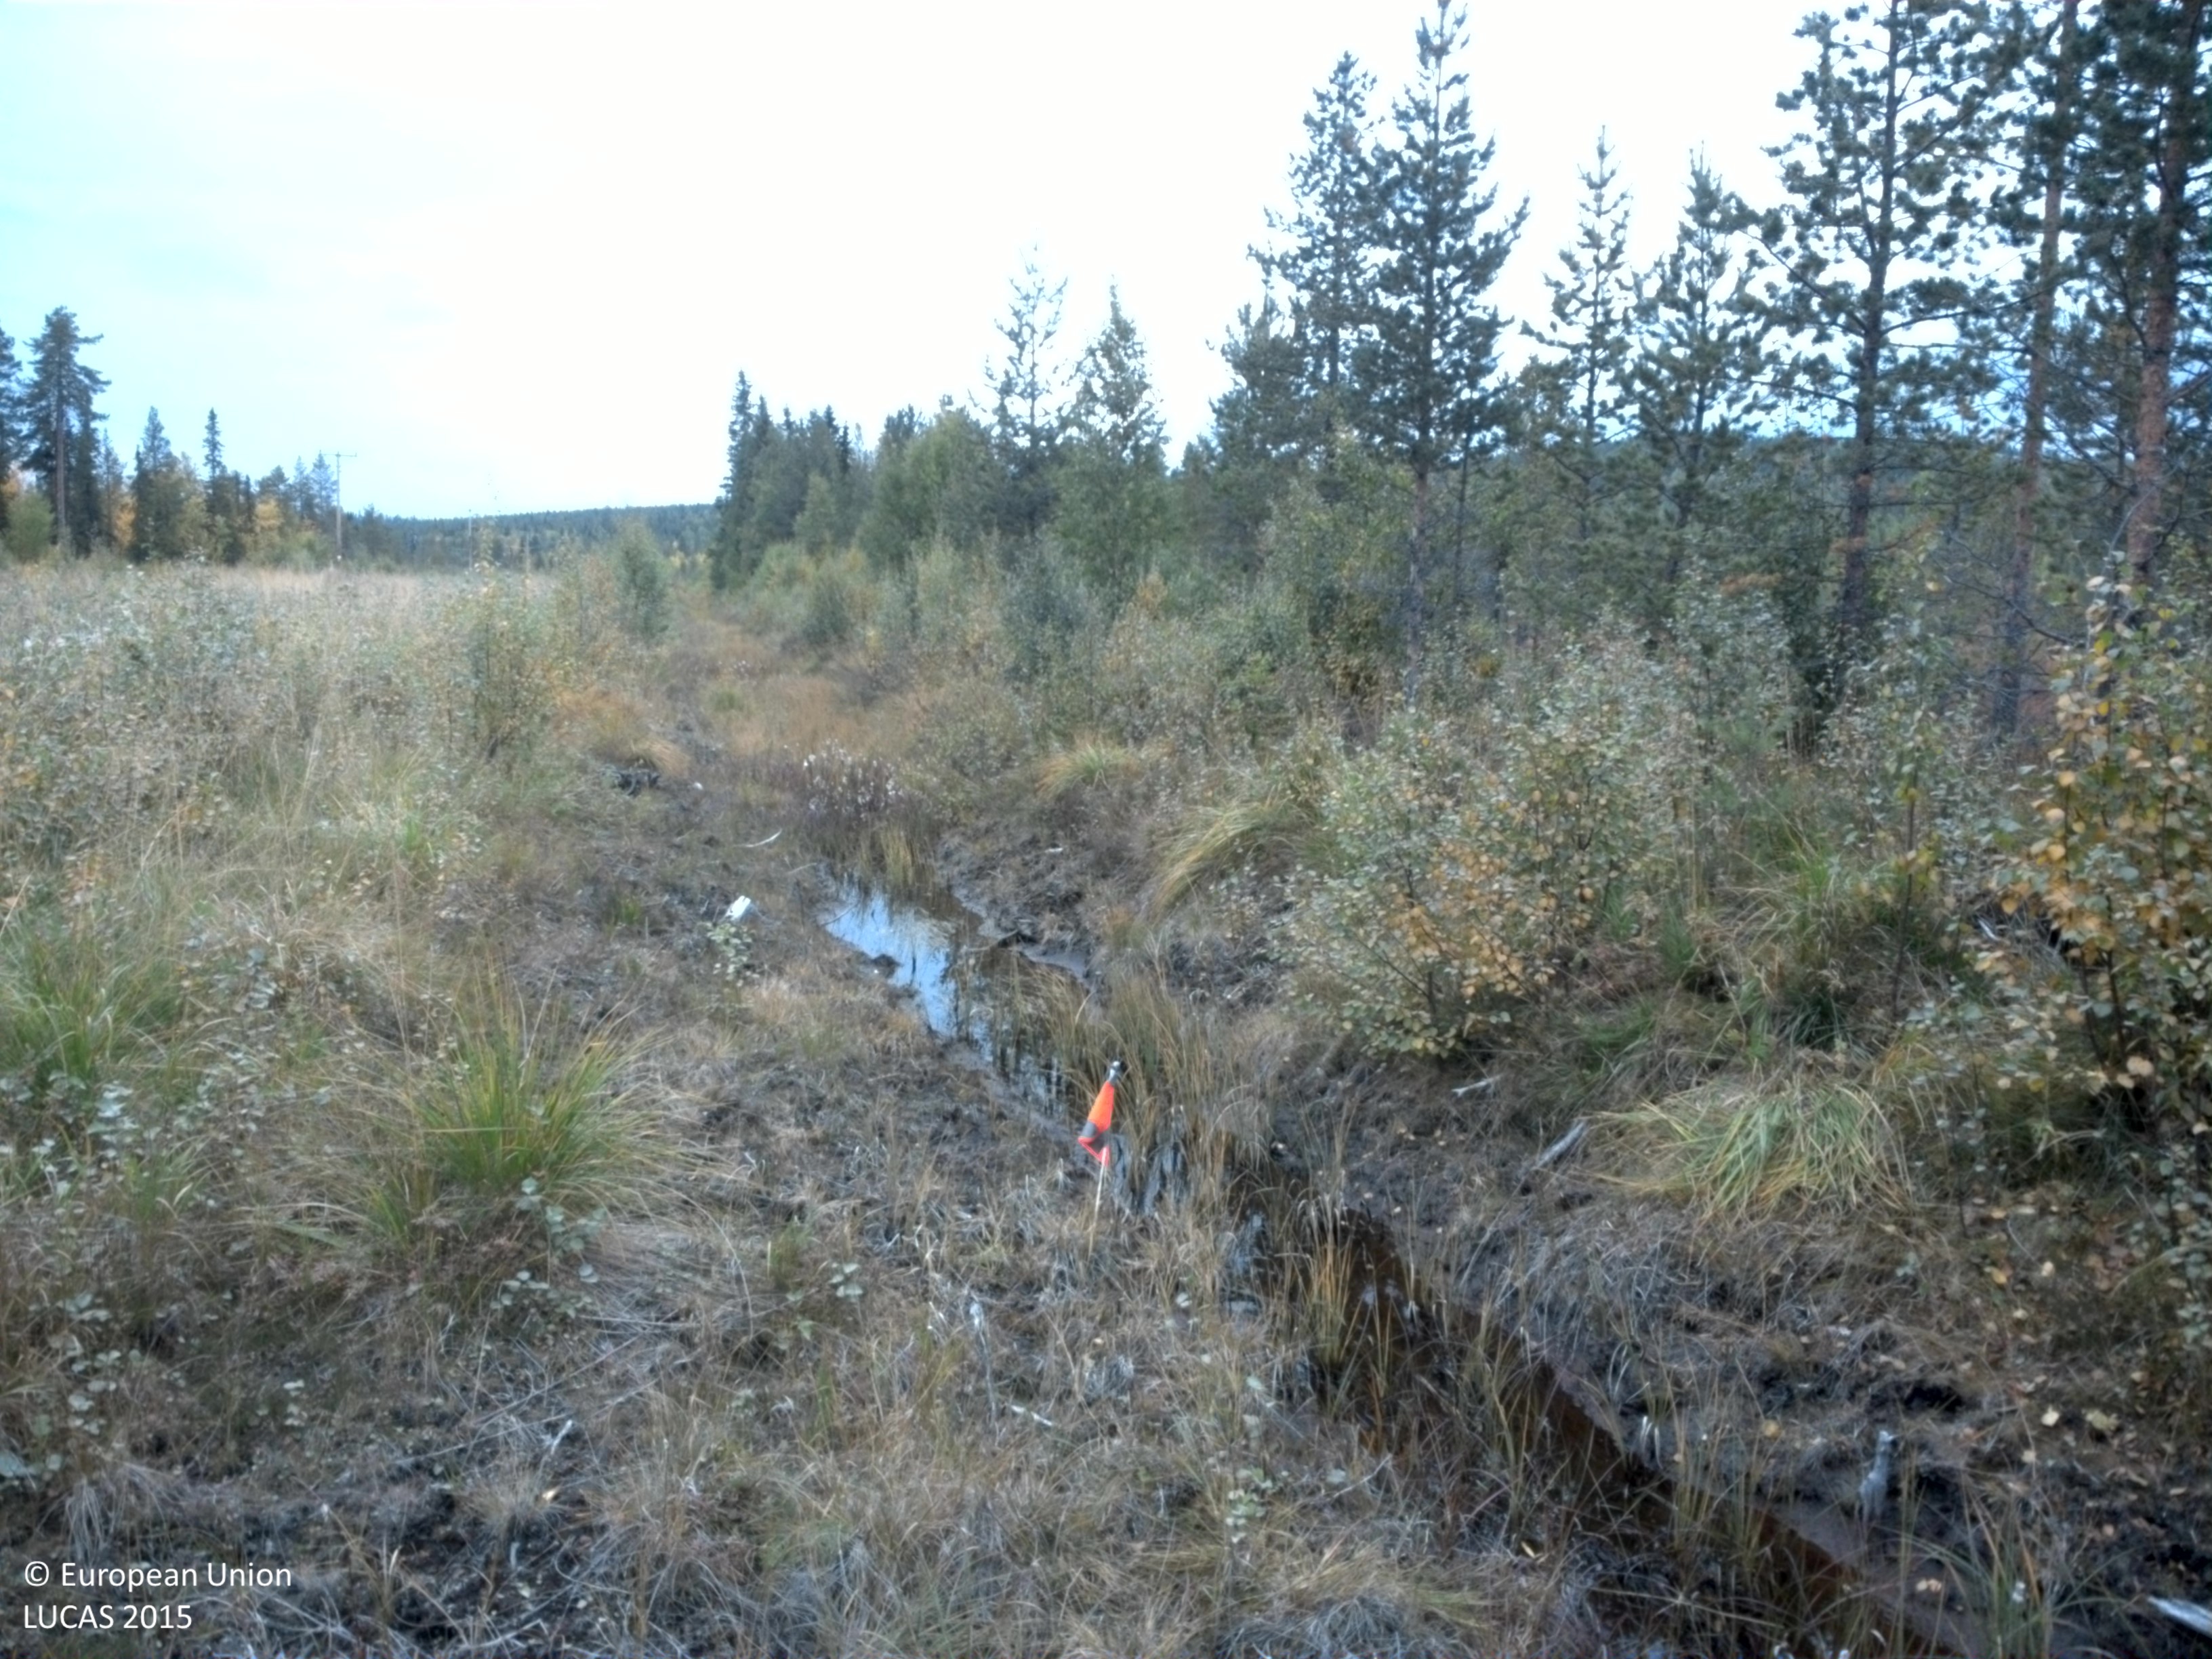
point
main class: Woodland
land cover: Broadleaved woodland
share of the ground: 25 - 50 %
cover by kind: herbaceous plants 60 %, broadleaved forest trees 30 %, coniferous forest trees 5 %, unconsolidated bare surface 5 %
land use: Semi-natural and natural areas not in use
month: September
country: SE
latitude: 65.1751
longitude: 16.8578
